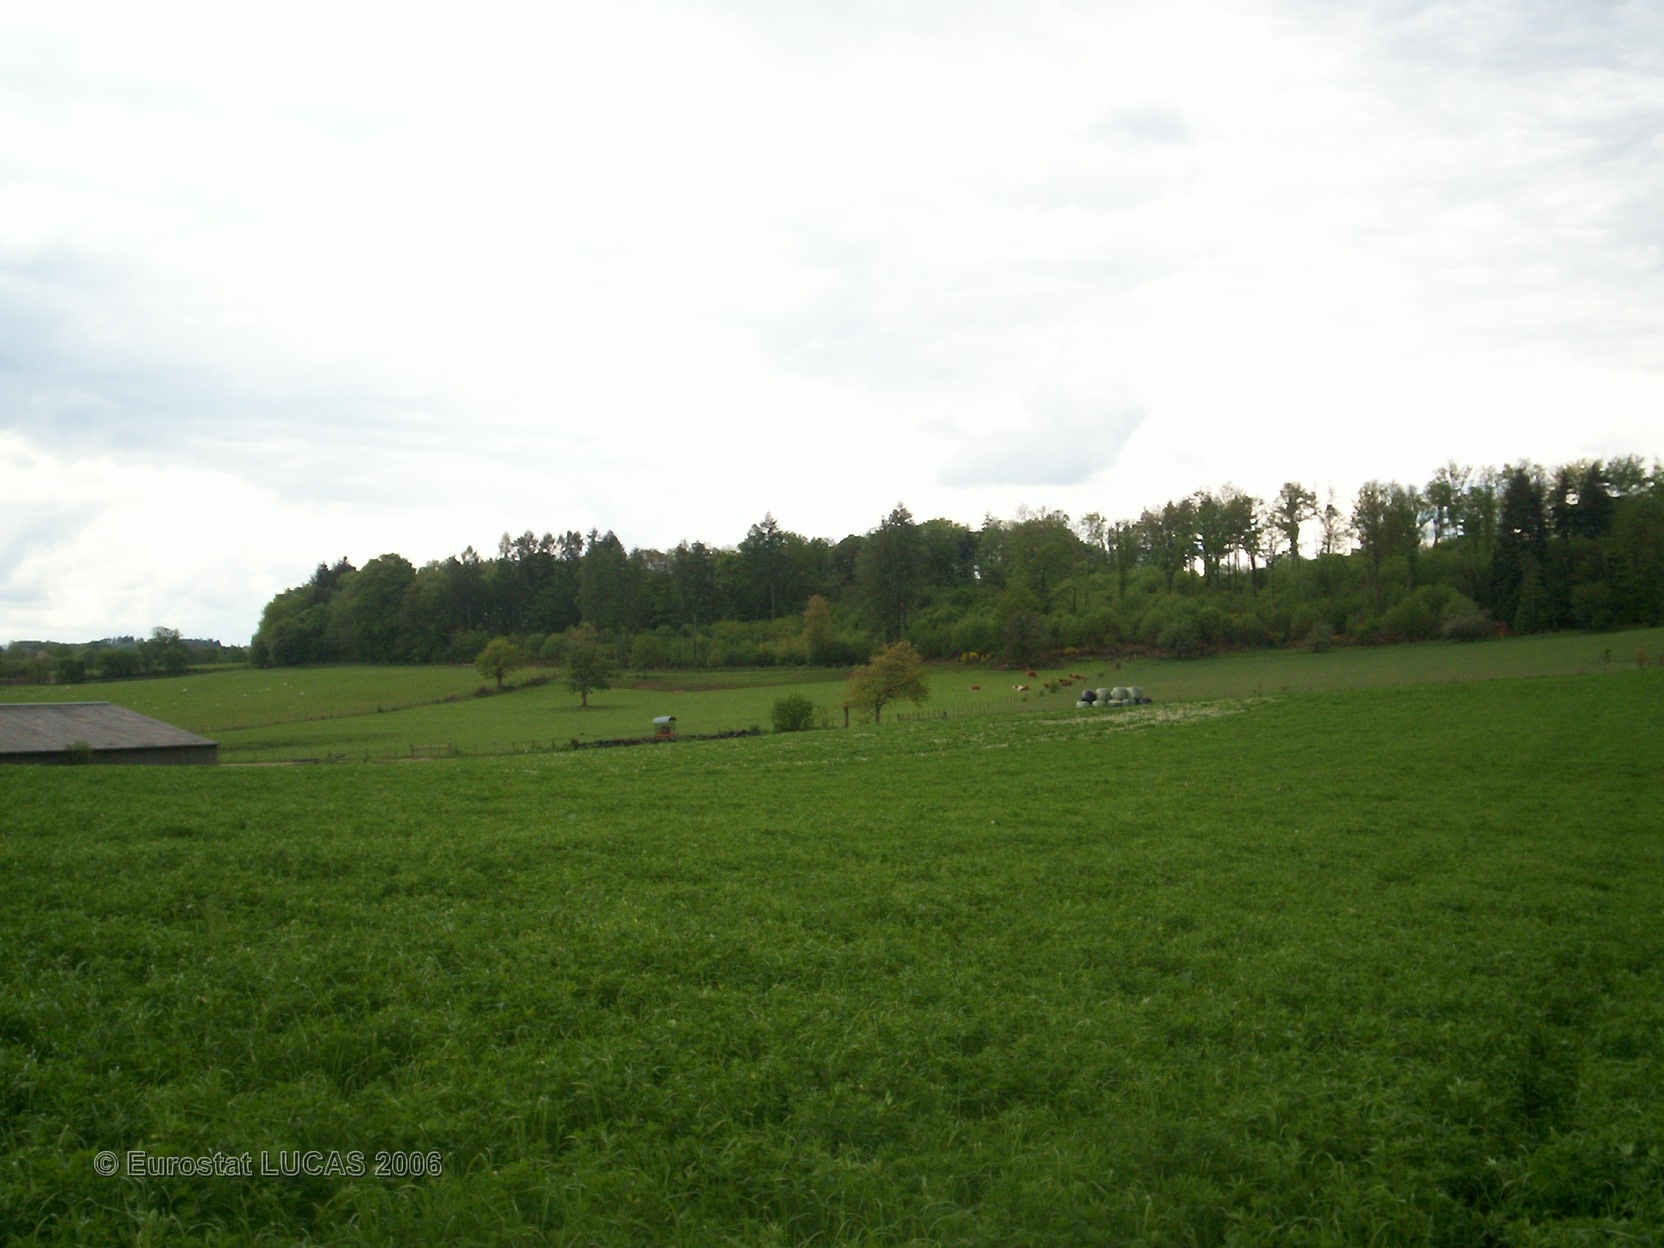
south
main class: Cropland
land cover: Lucerne
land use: Agriculture (excluding fallow land and kitchen gardens)
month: May
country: FR
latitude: 45.7446
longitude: 1.5482
